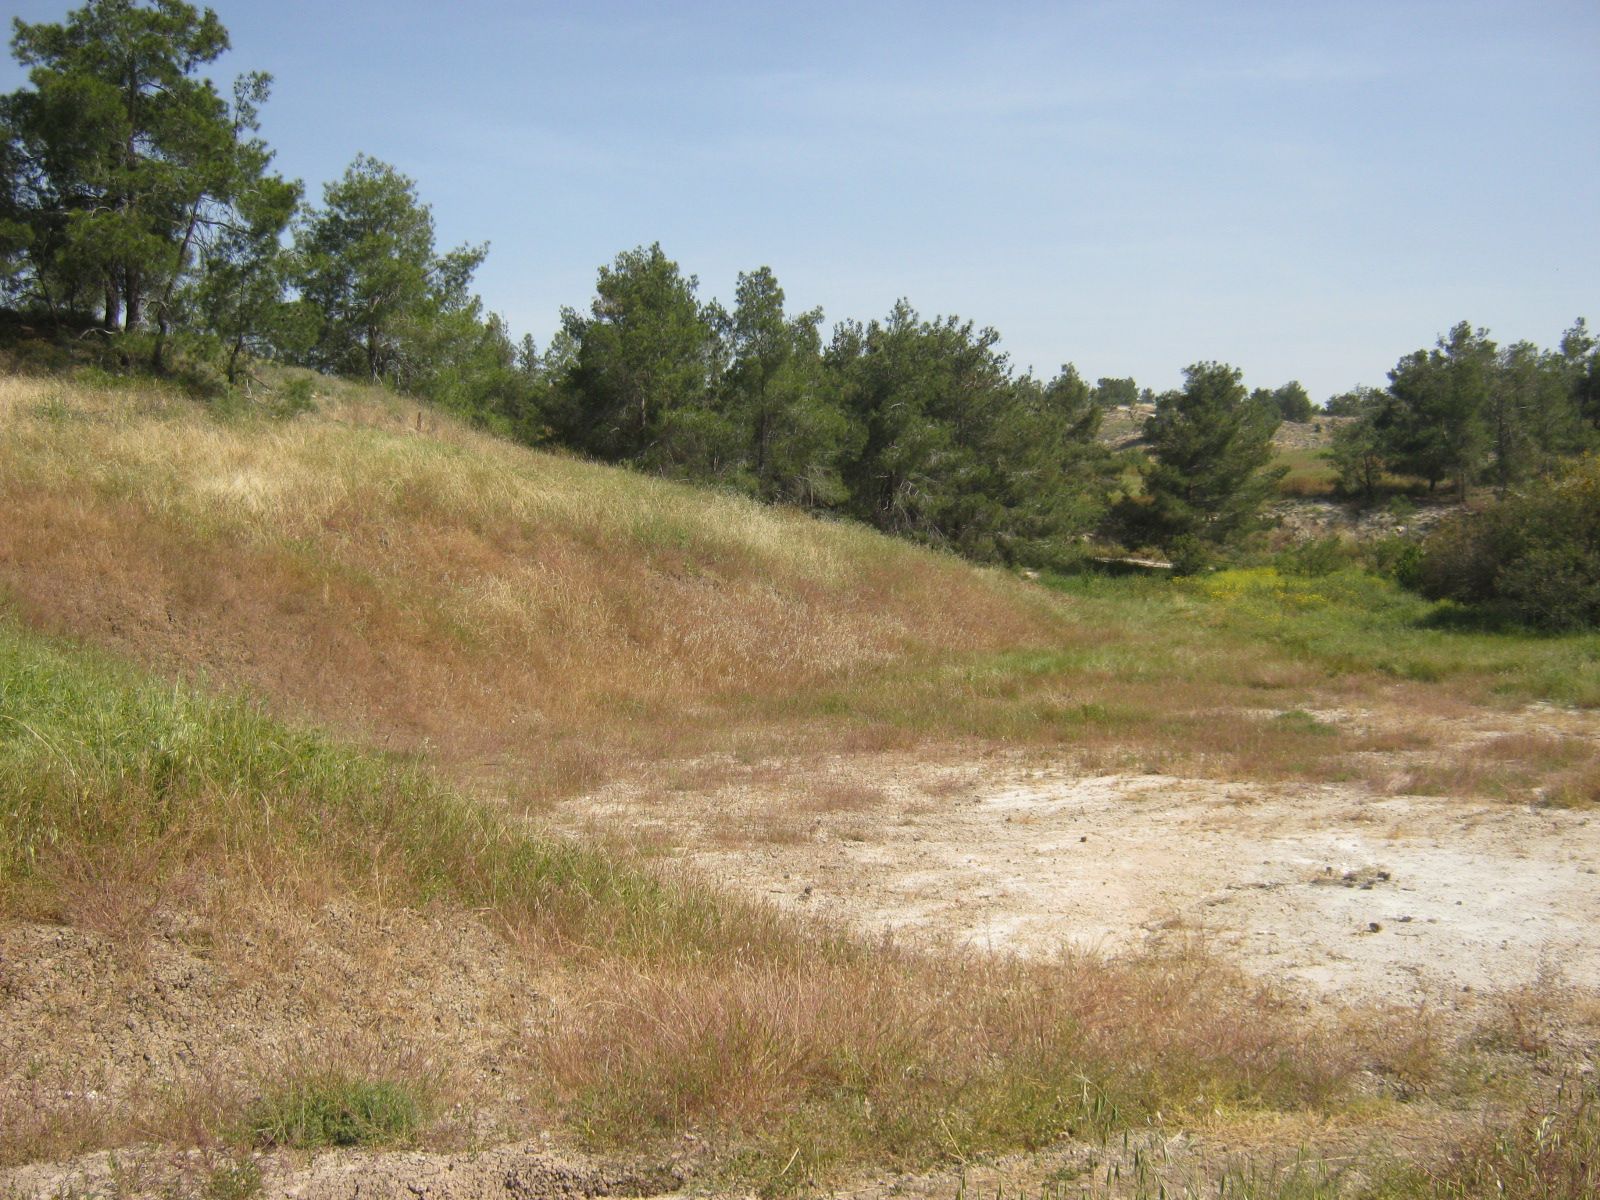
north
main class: Grassland
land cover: Grassland with sparse tree/shrub cover
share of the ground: > 75 %
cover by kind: herbaceous plants 95 %, broadleaved forest trees 5 %
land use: Semi-natural and natural areas not in use
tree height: > 5 m
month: April
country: CY
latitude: 35.0162
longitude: 33.2301
